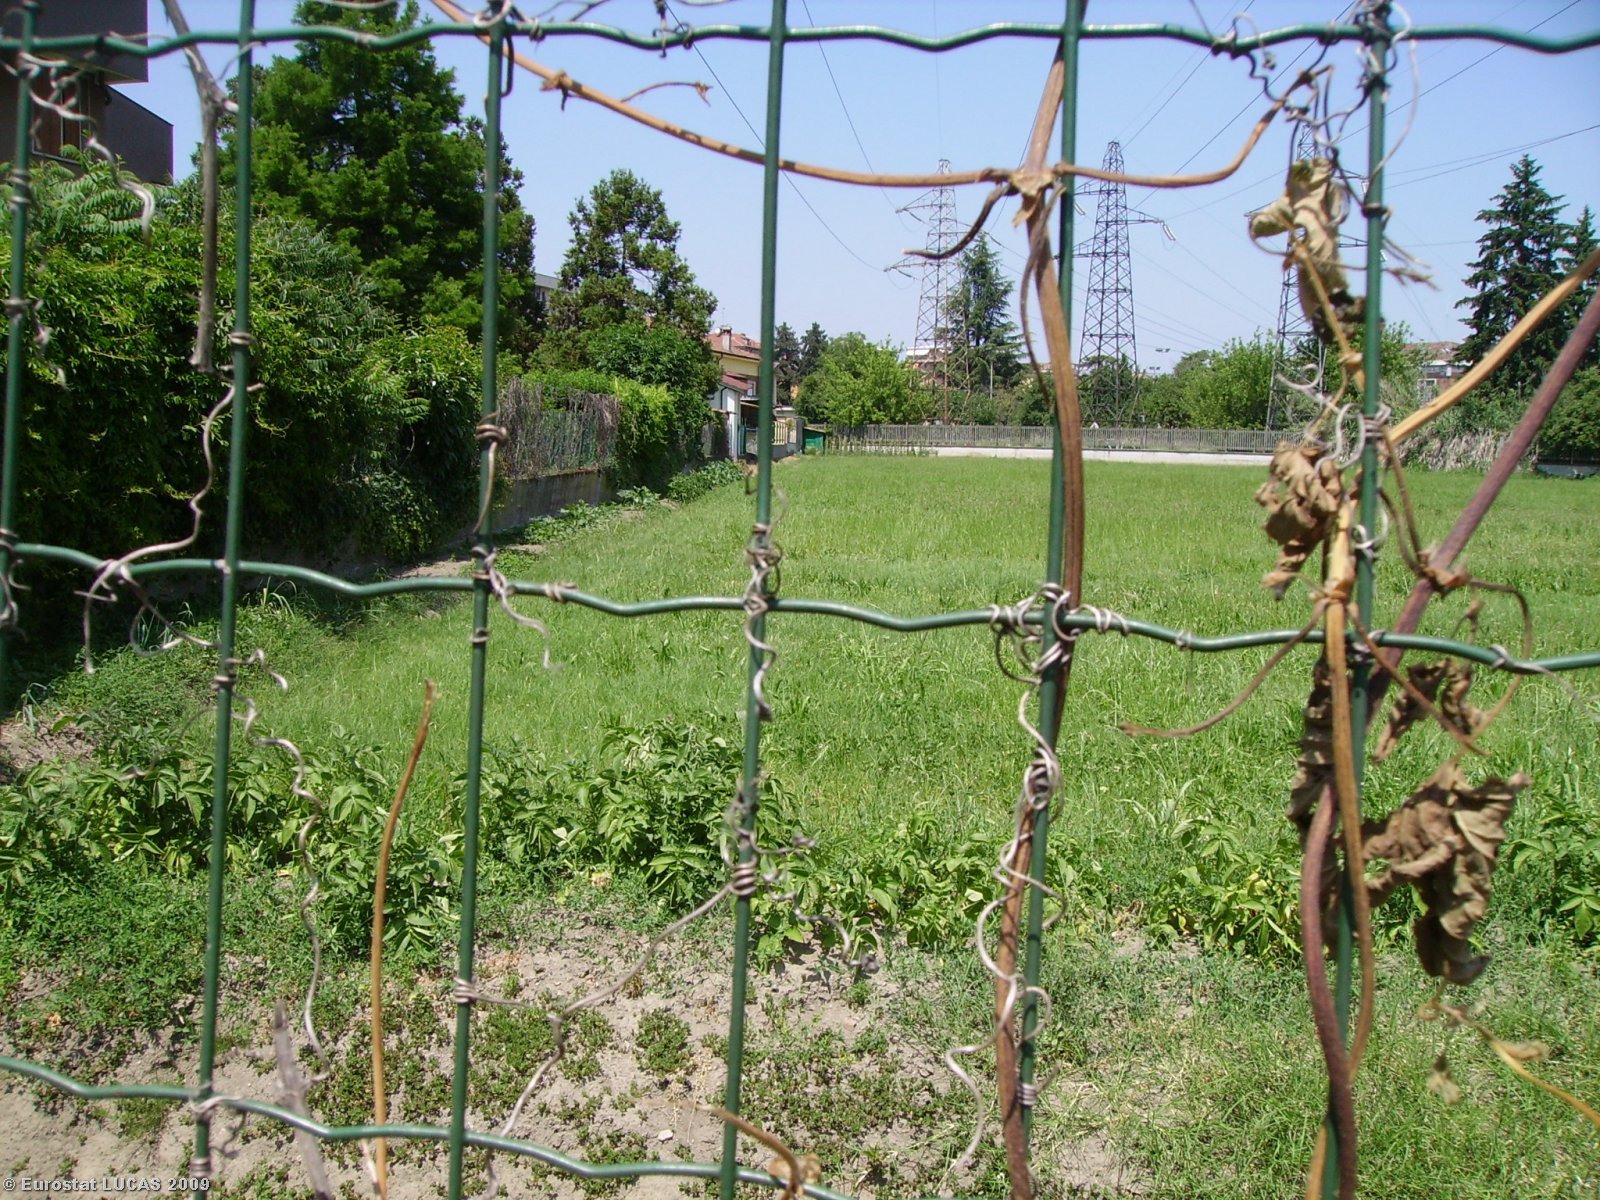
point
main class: Grassland
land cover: Grassland without tree/shrub cover
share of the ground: > 75 %
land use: Fallow land
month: June
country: IT
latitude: 45.3050
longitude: 9.5035
